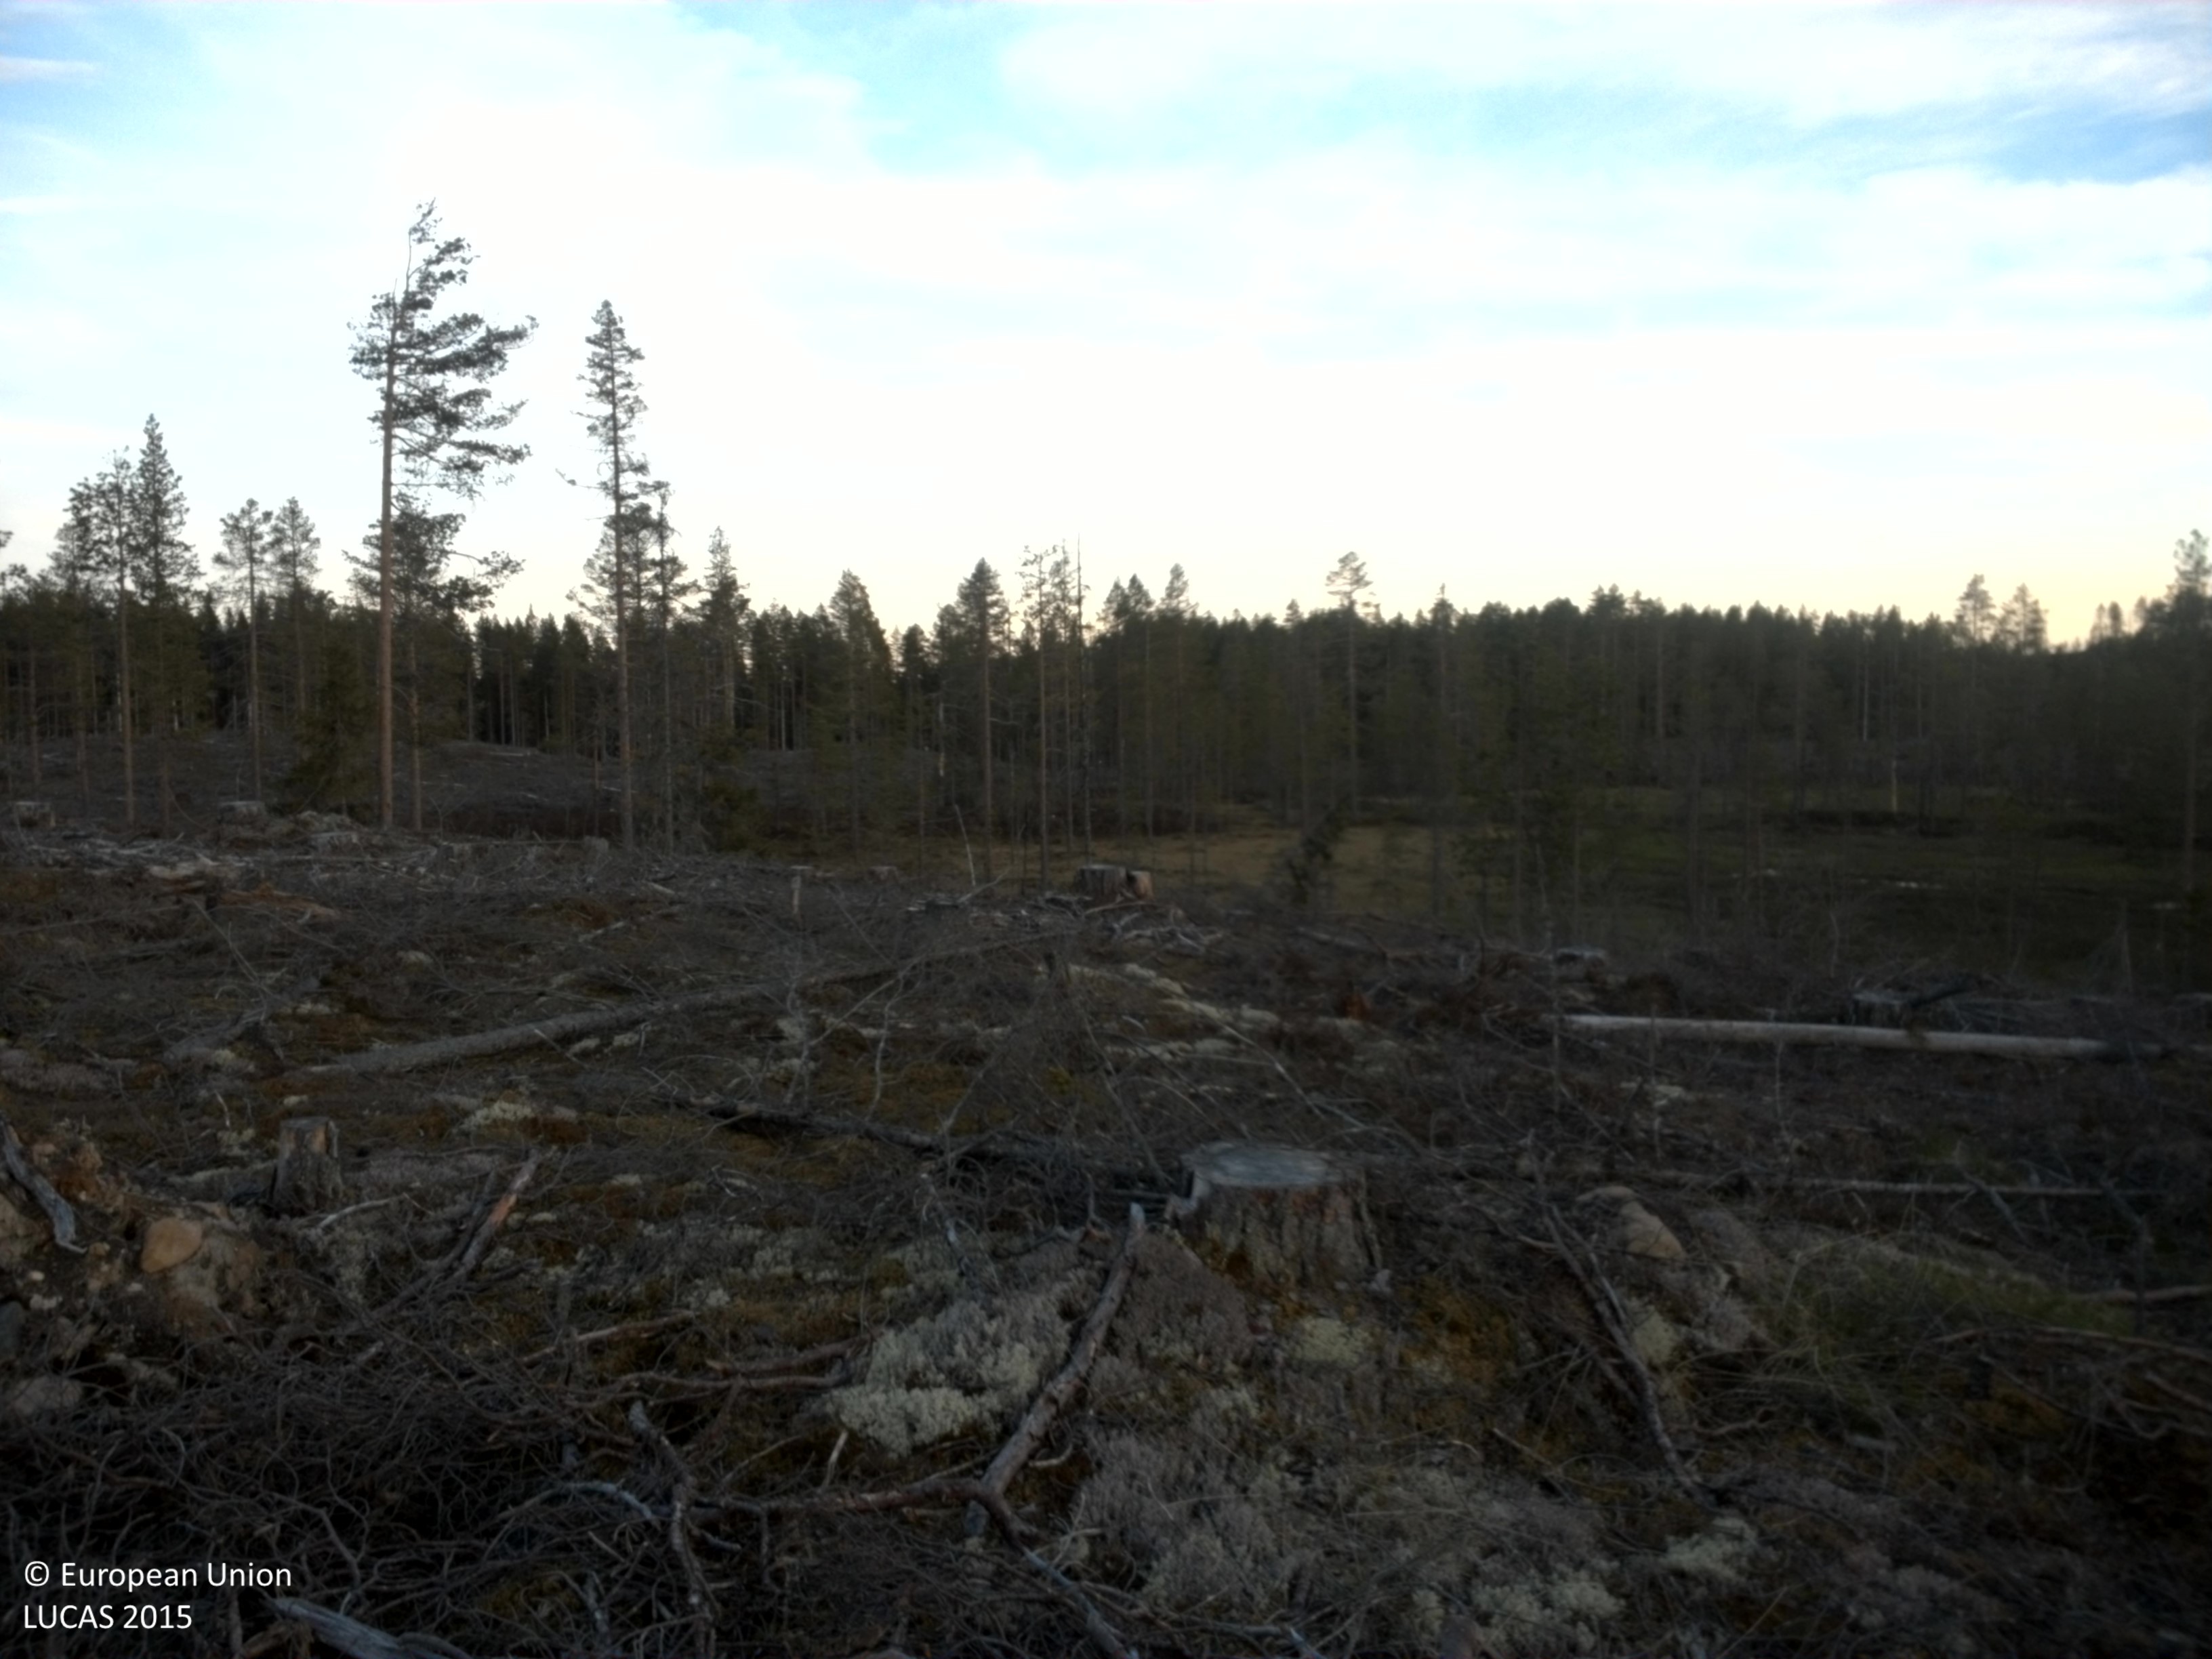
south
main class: Shrubland
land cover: Shrubland with sparse tree cover
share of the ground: 50 - 75 %
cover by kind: shrubs 55 %, lichens and mosses 10 %, consolidated bare surface 10 %, coniferous forest trees 5 %
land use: Forestry
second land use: Amenities, museums, leisure
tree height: > 5 m
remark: Clear cut
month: June
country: SE
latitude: 61.1321
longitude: 13.3494
